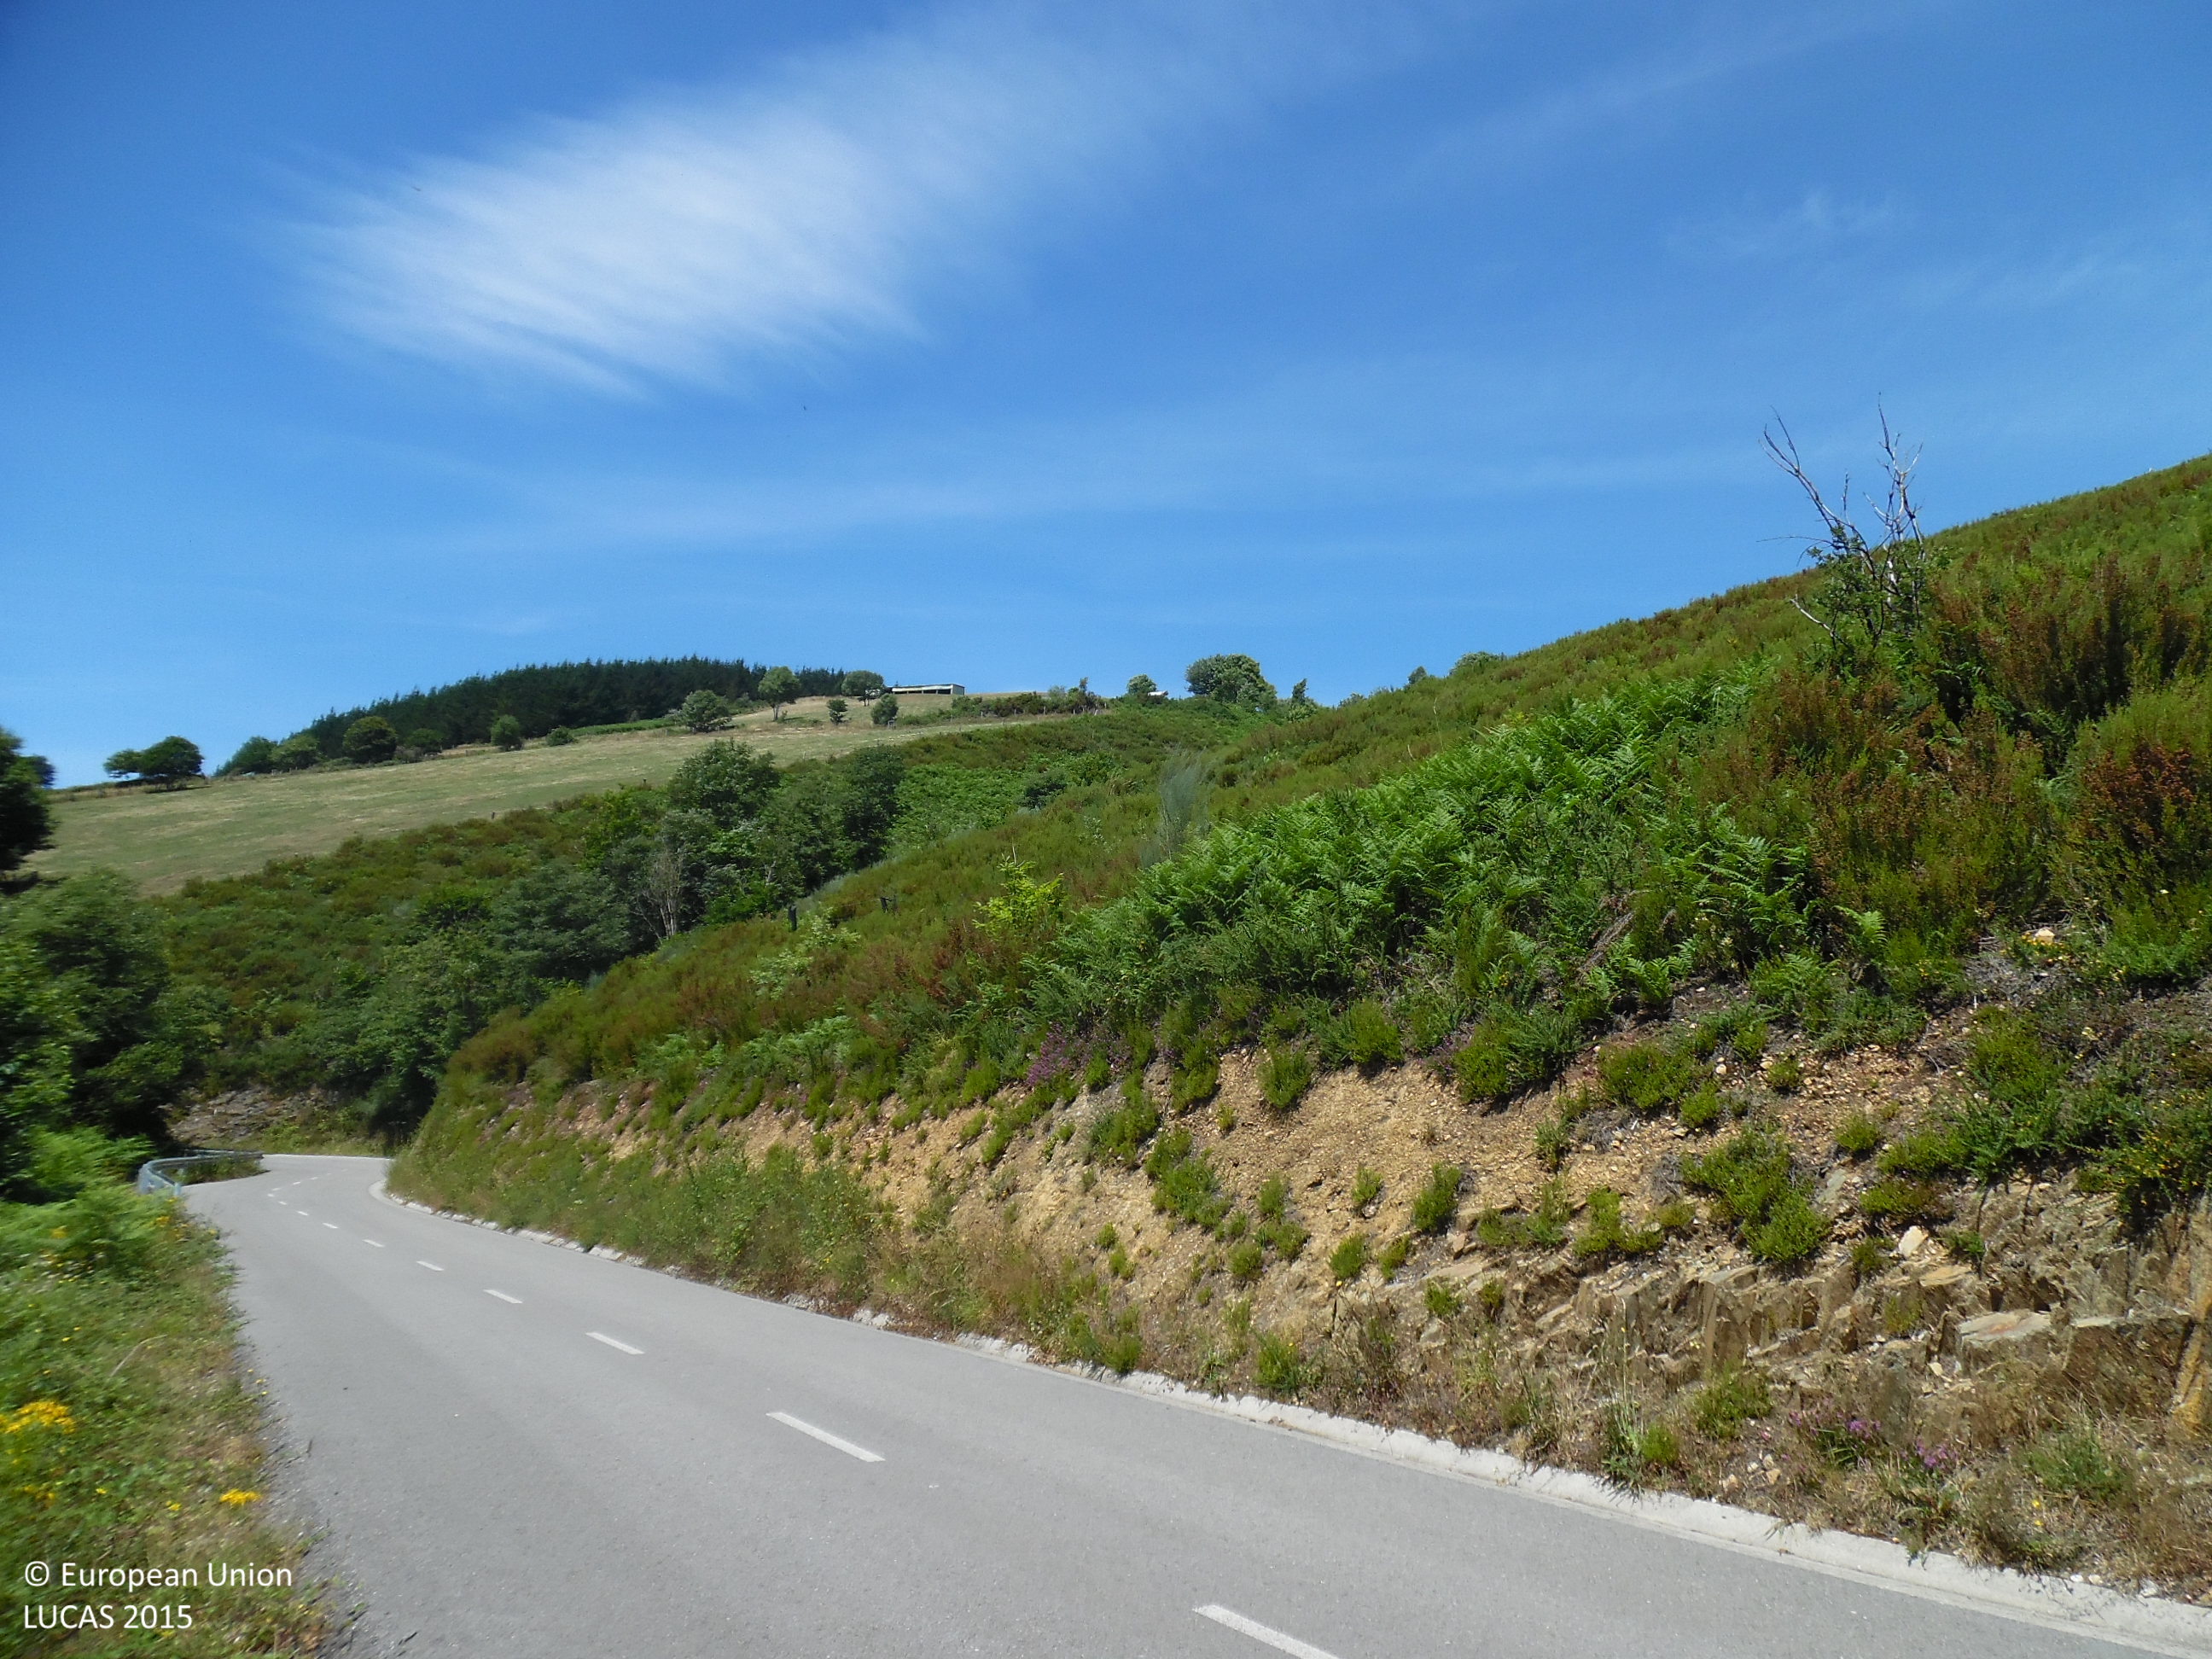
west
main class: Shrubland
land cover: Shrubland with sparse tree cover
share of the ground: 50 - 75 %
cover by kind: shrubs 80 %, consolidated bare surface 15 %, broadleaved forest trees 5 %
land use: Forestry
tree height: < 5 m
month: July
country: ES
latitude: 43.2031
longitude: -6.6079
